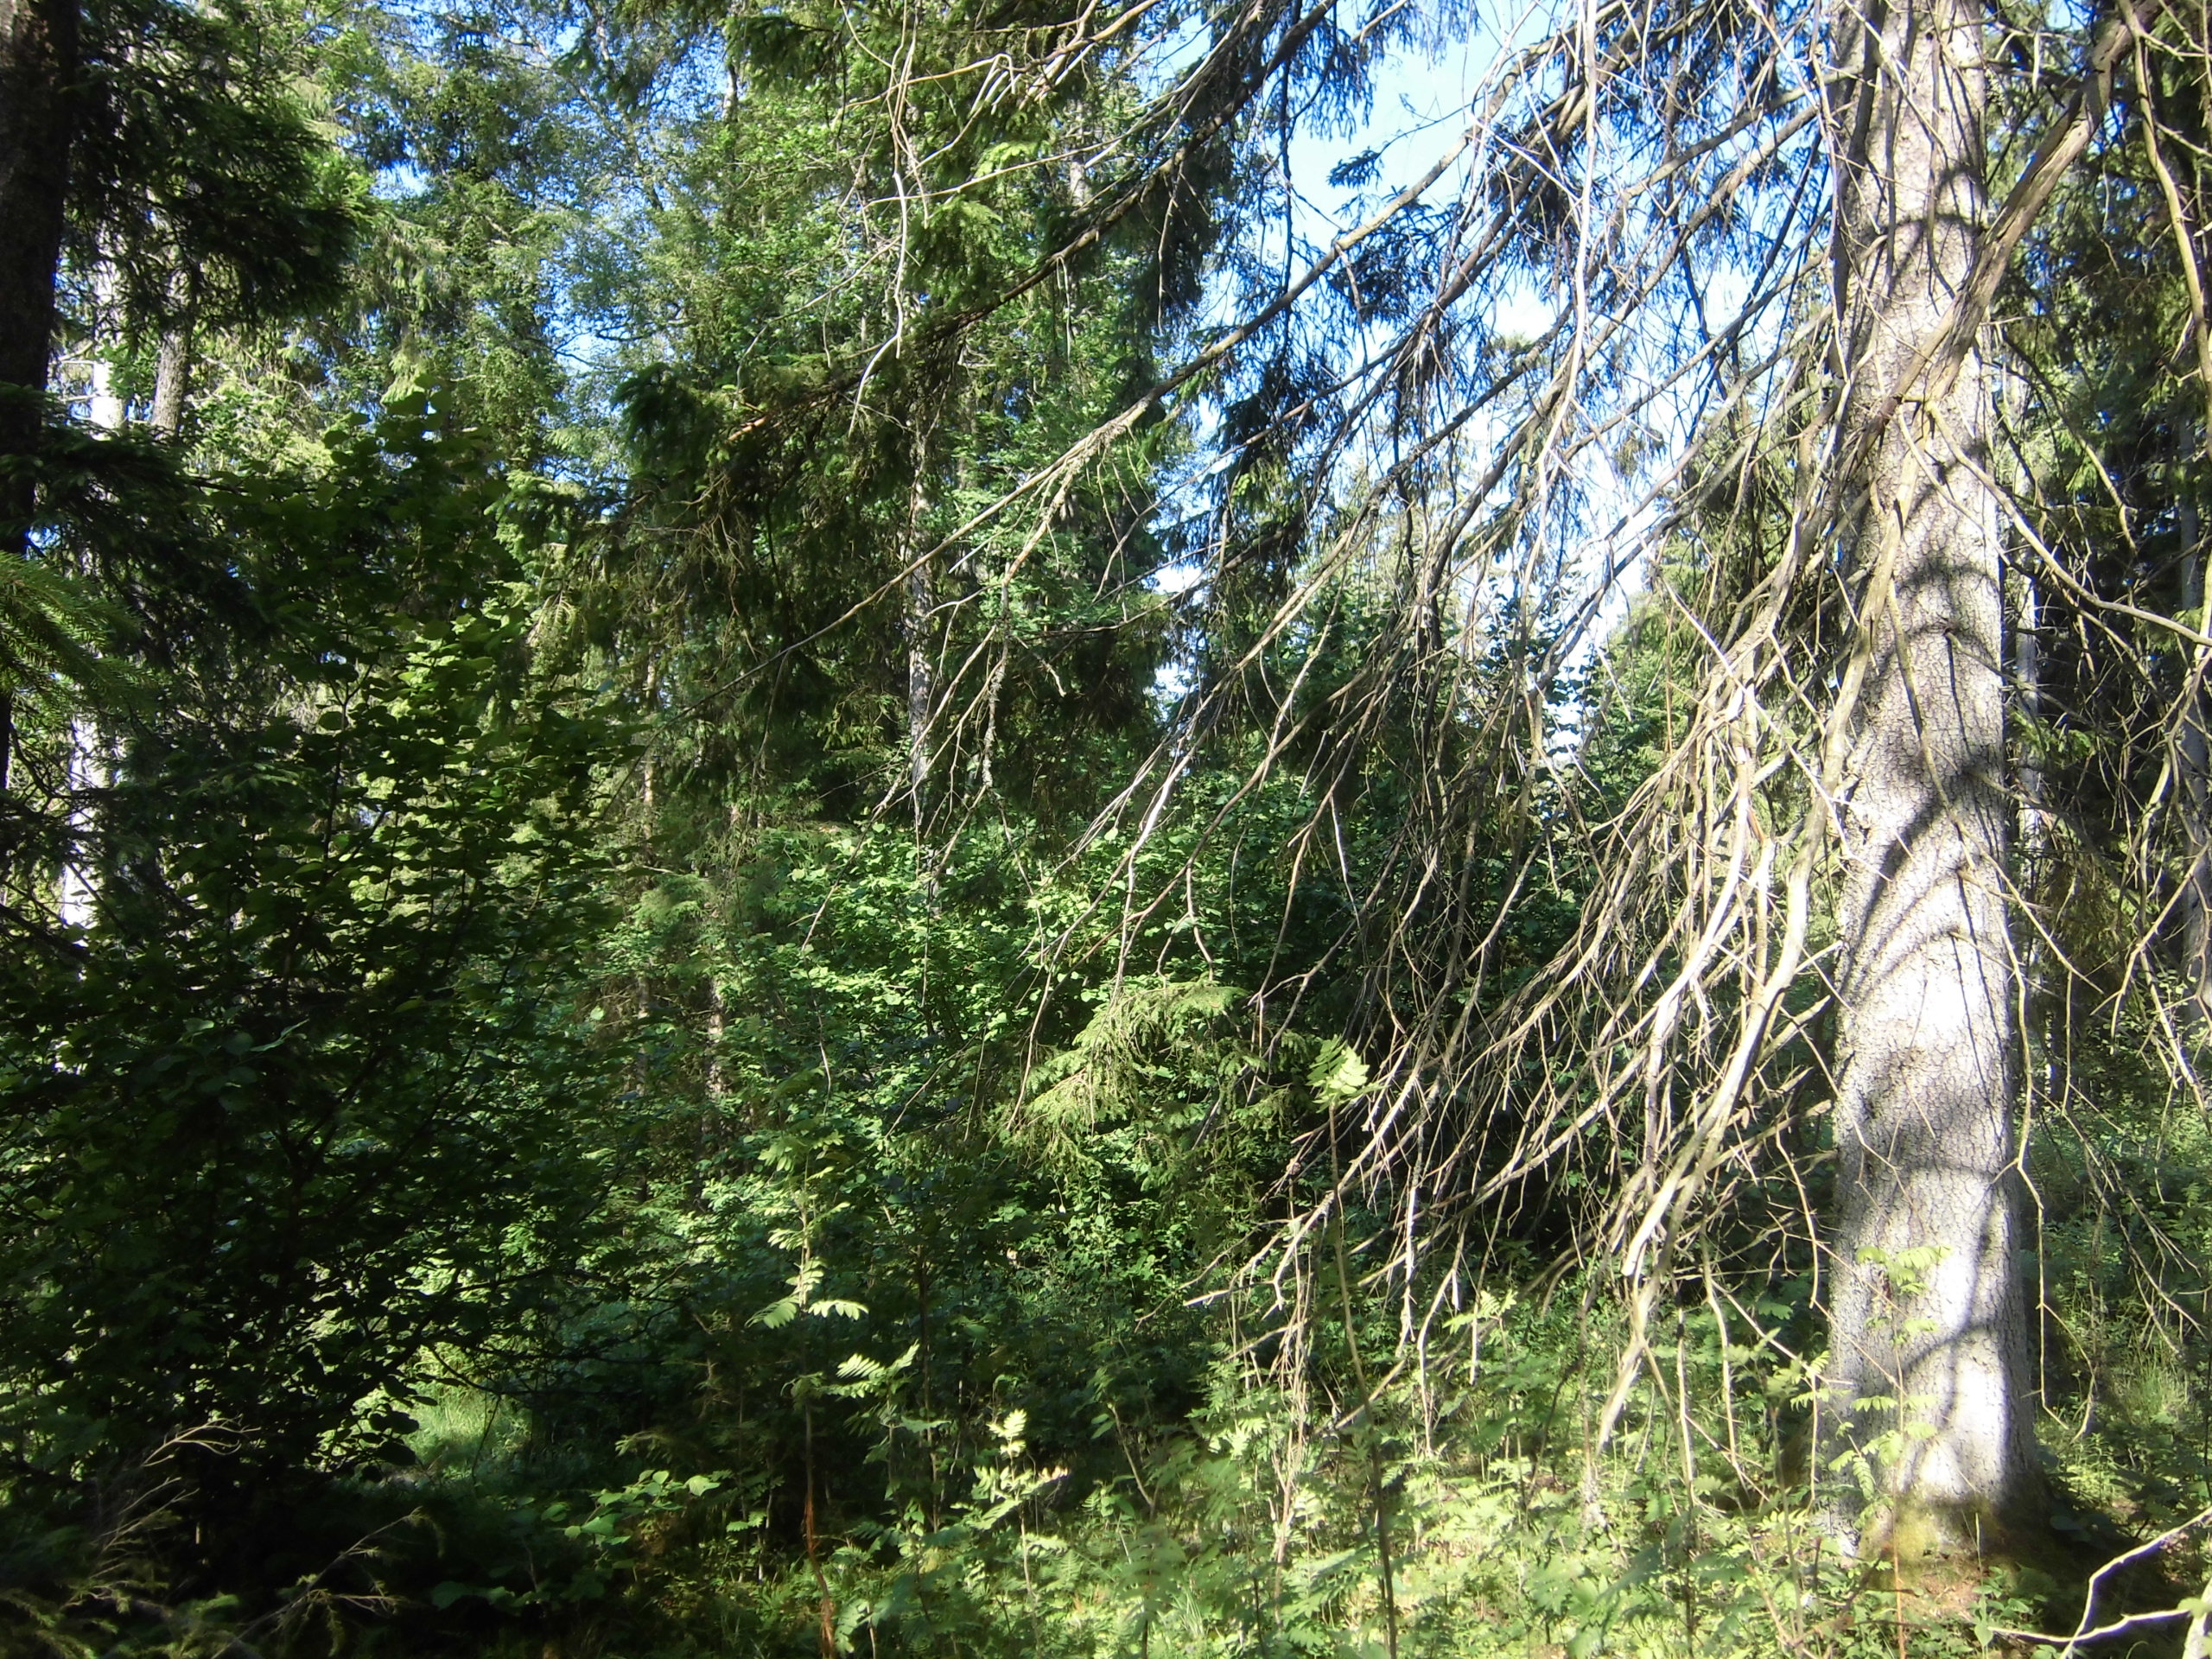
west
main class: Woodland
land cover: Spruce dominated coniferous woodland
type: boreal forest
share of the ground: 50 - 75 %
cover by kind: coniferous forest trees 50 %, herbaceous plants 20 %, broadleaved forest trees 10 %, shrubs 10 %, lichens and mosses 10 %
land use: Forestry
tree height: > 5 m
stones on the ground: 10 - 25 %
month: July
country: SE
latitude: 57.2323
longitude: 14.8172
